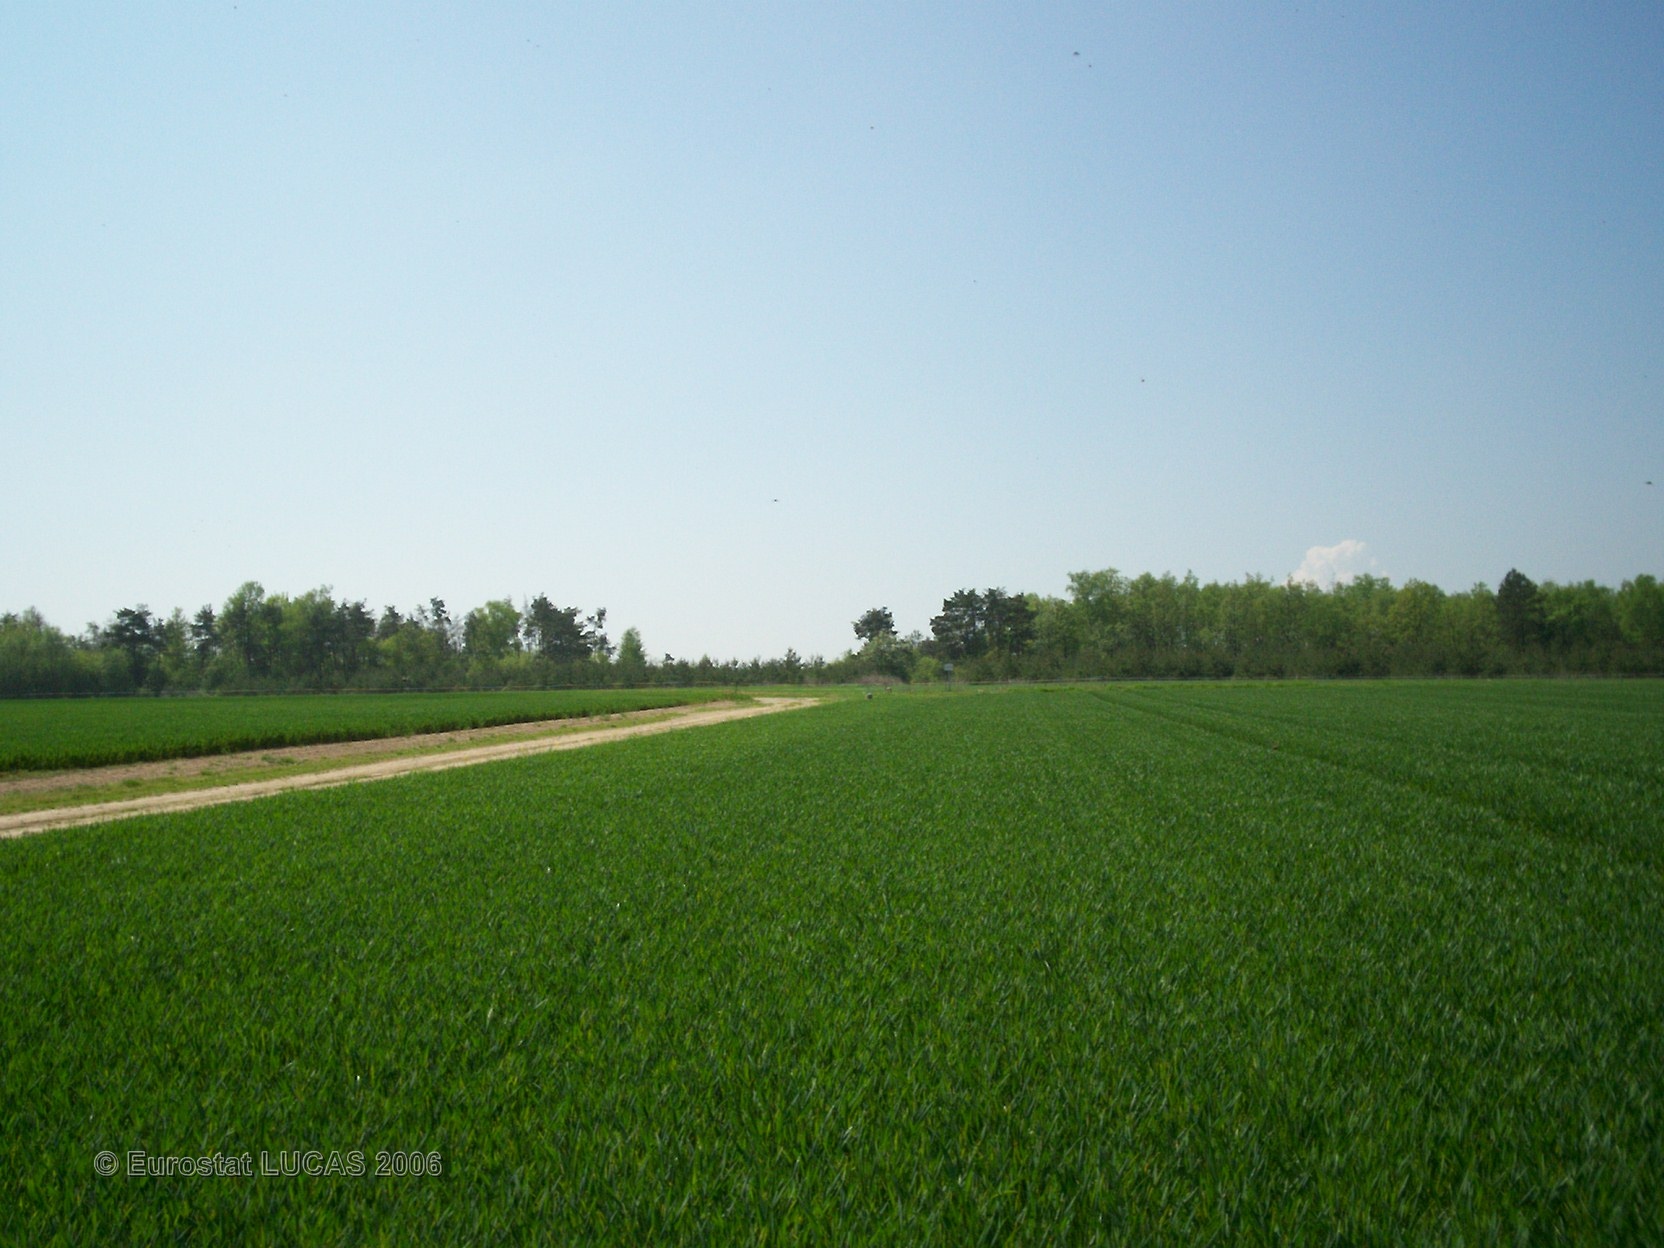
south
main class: Cropland
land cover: Common wheat
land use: Agriculture (excluding fallow land and kitchen gardens)
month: May
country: FR
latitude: 49.2509
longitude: 4.3496
